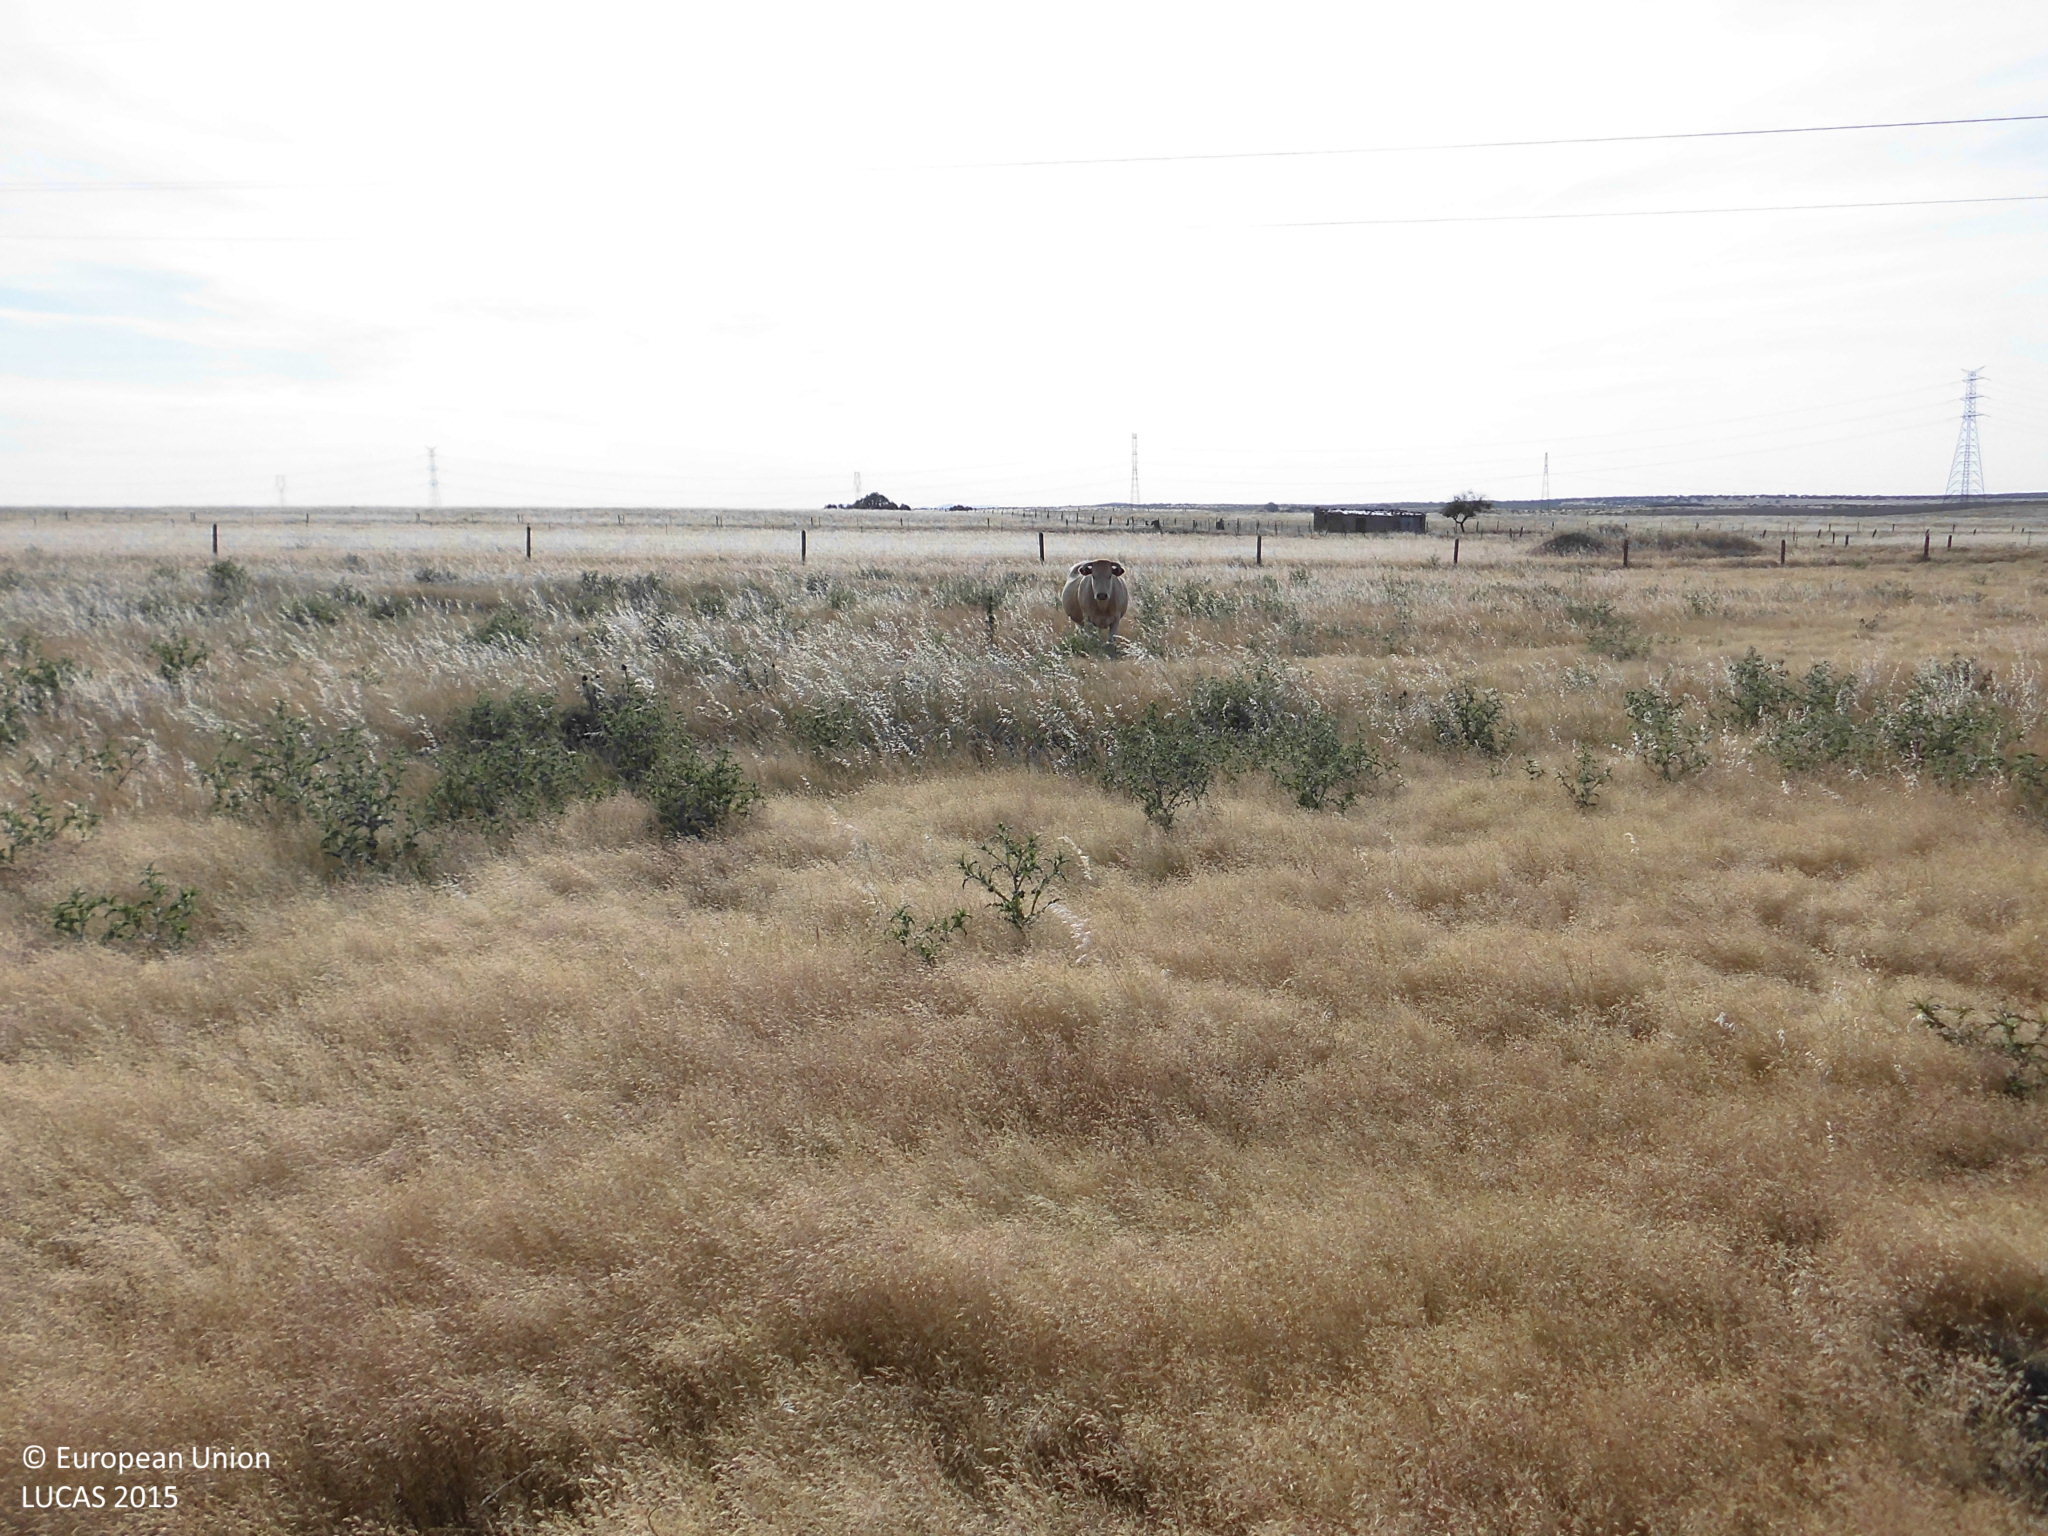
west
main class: Grassland
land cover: Grassland without tree/shrub cover
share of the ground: > 75 %
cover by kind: herbaceous plants 100 %
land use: Agriculture (excluding fallow land and kitchen gardens)
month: May
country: ES
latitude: 39.4154
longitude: -5.9360
